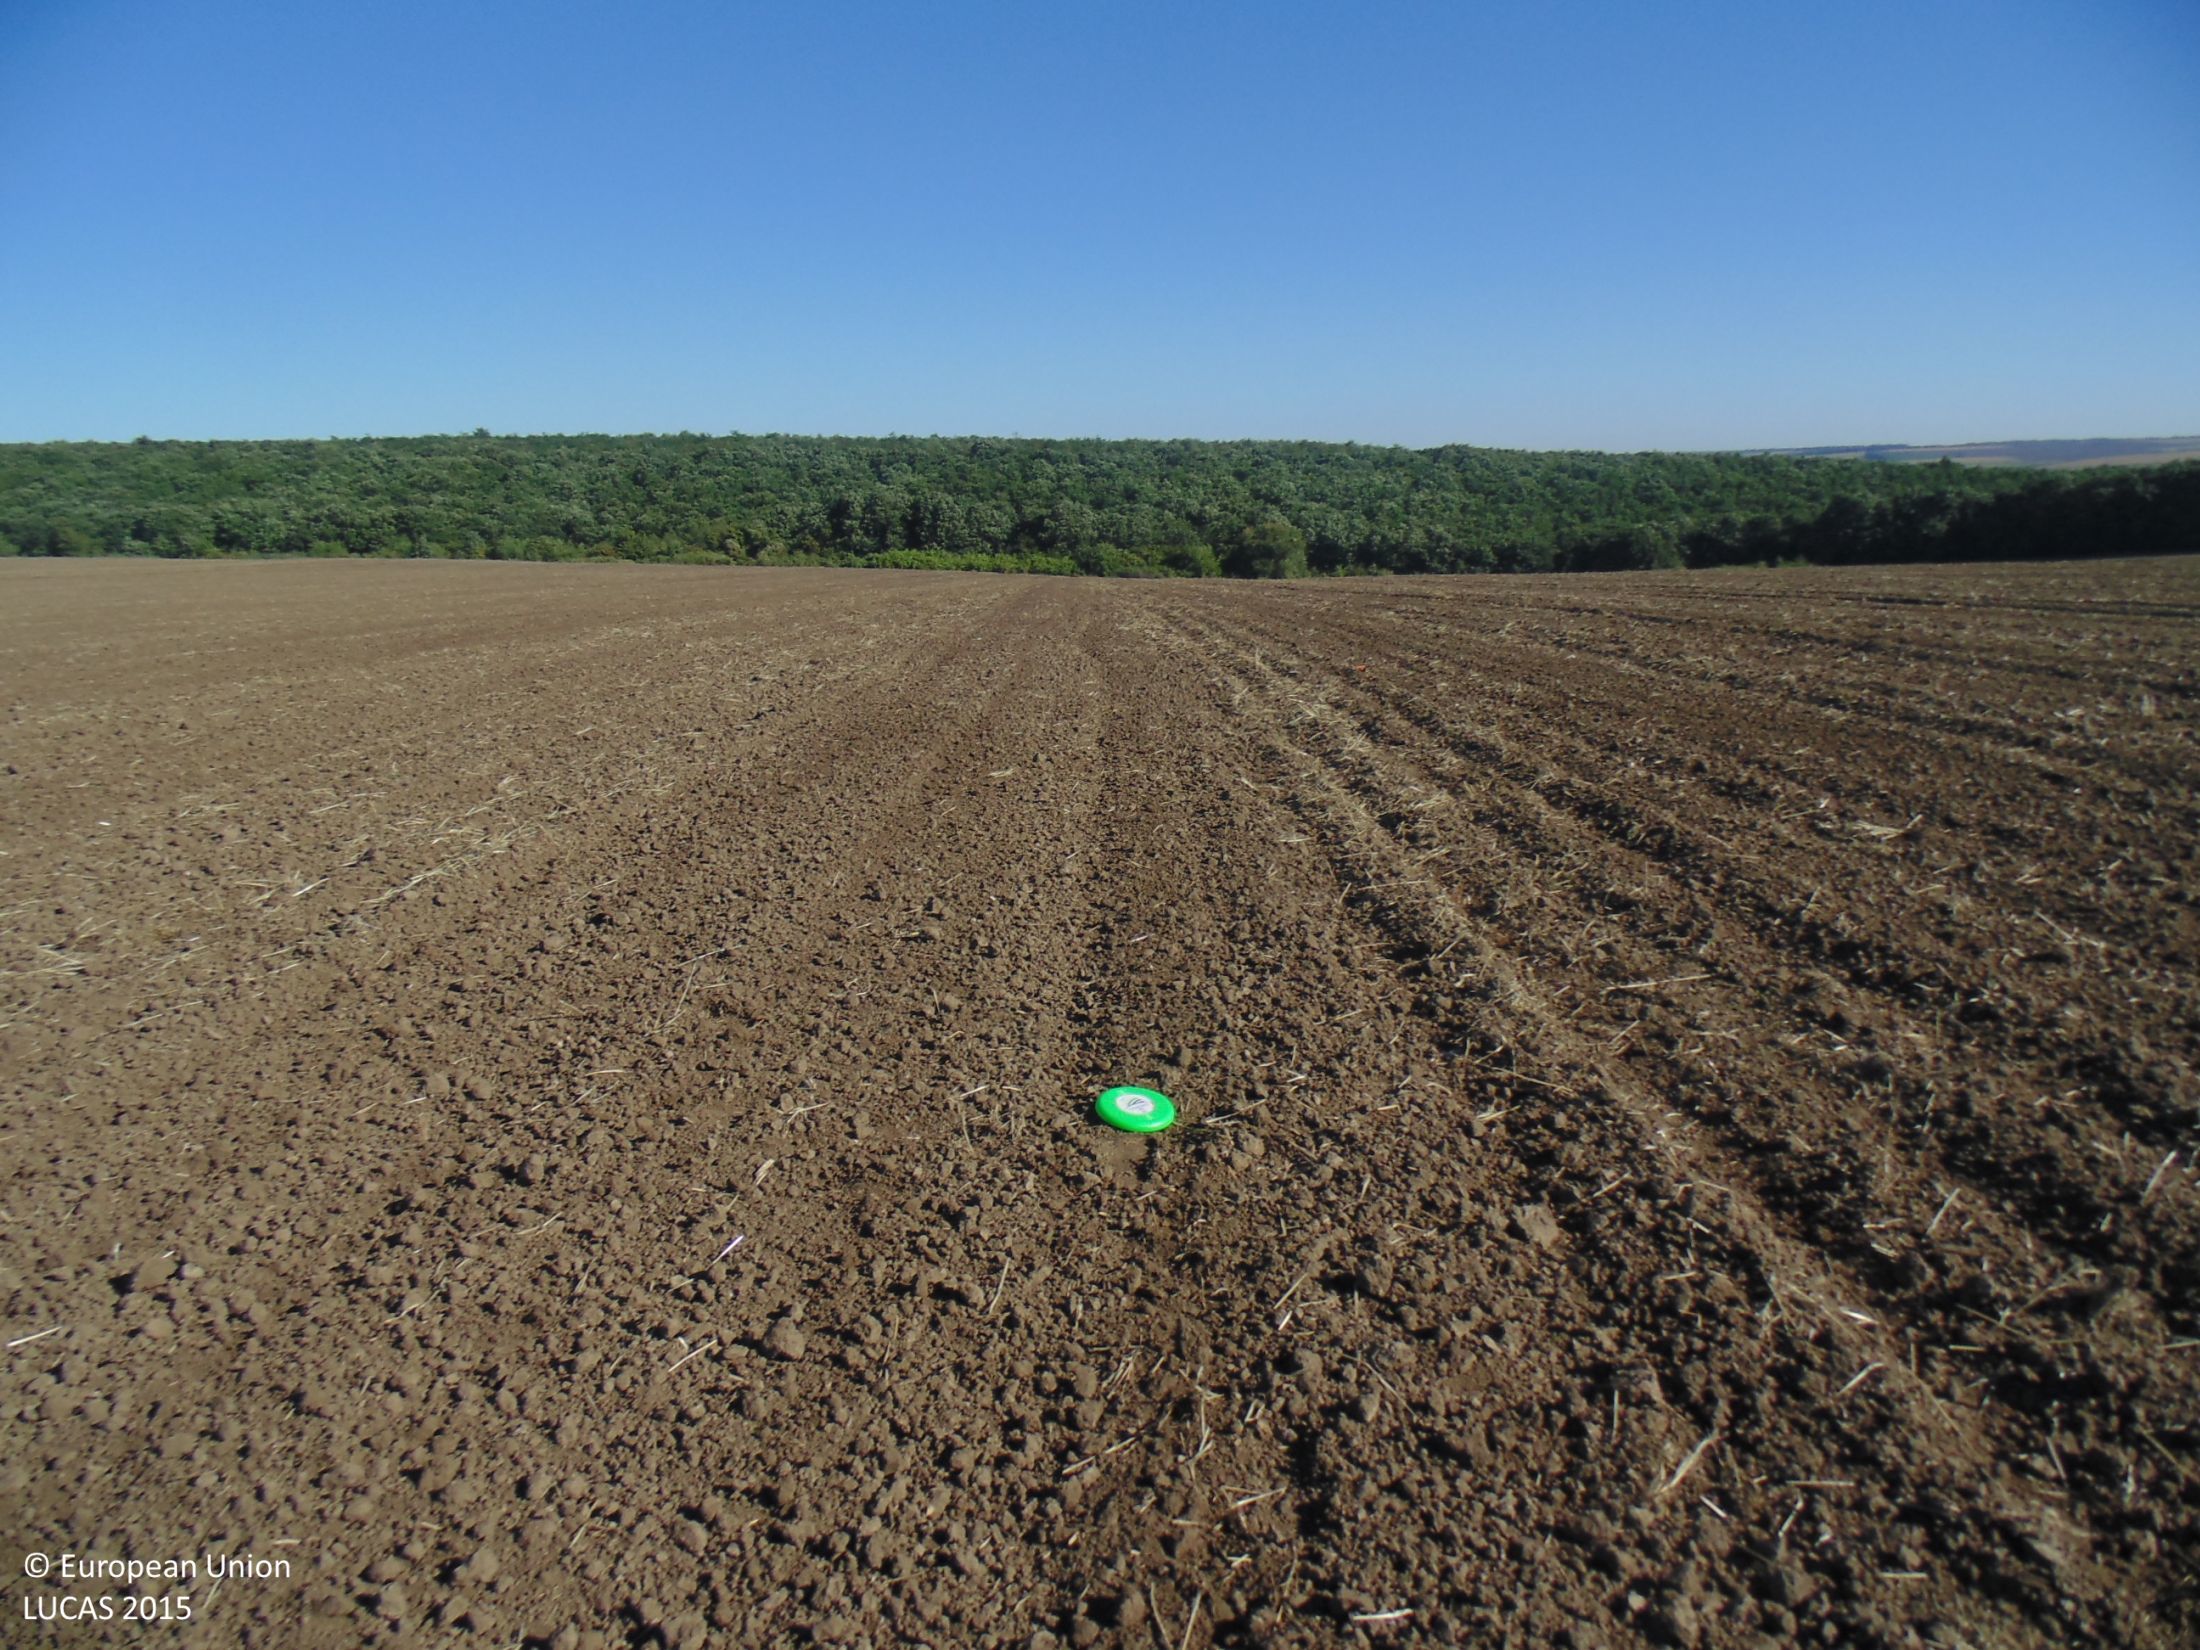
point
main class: Cropland
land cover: Common wheat
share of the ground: < 10 %
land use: Agriculture (excluding fallow land and kitchen gardens)
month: September
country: BG
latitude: 43.7663
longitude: 27.3089
